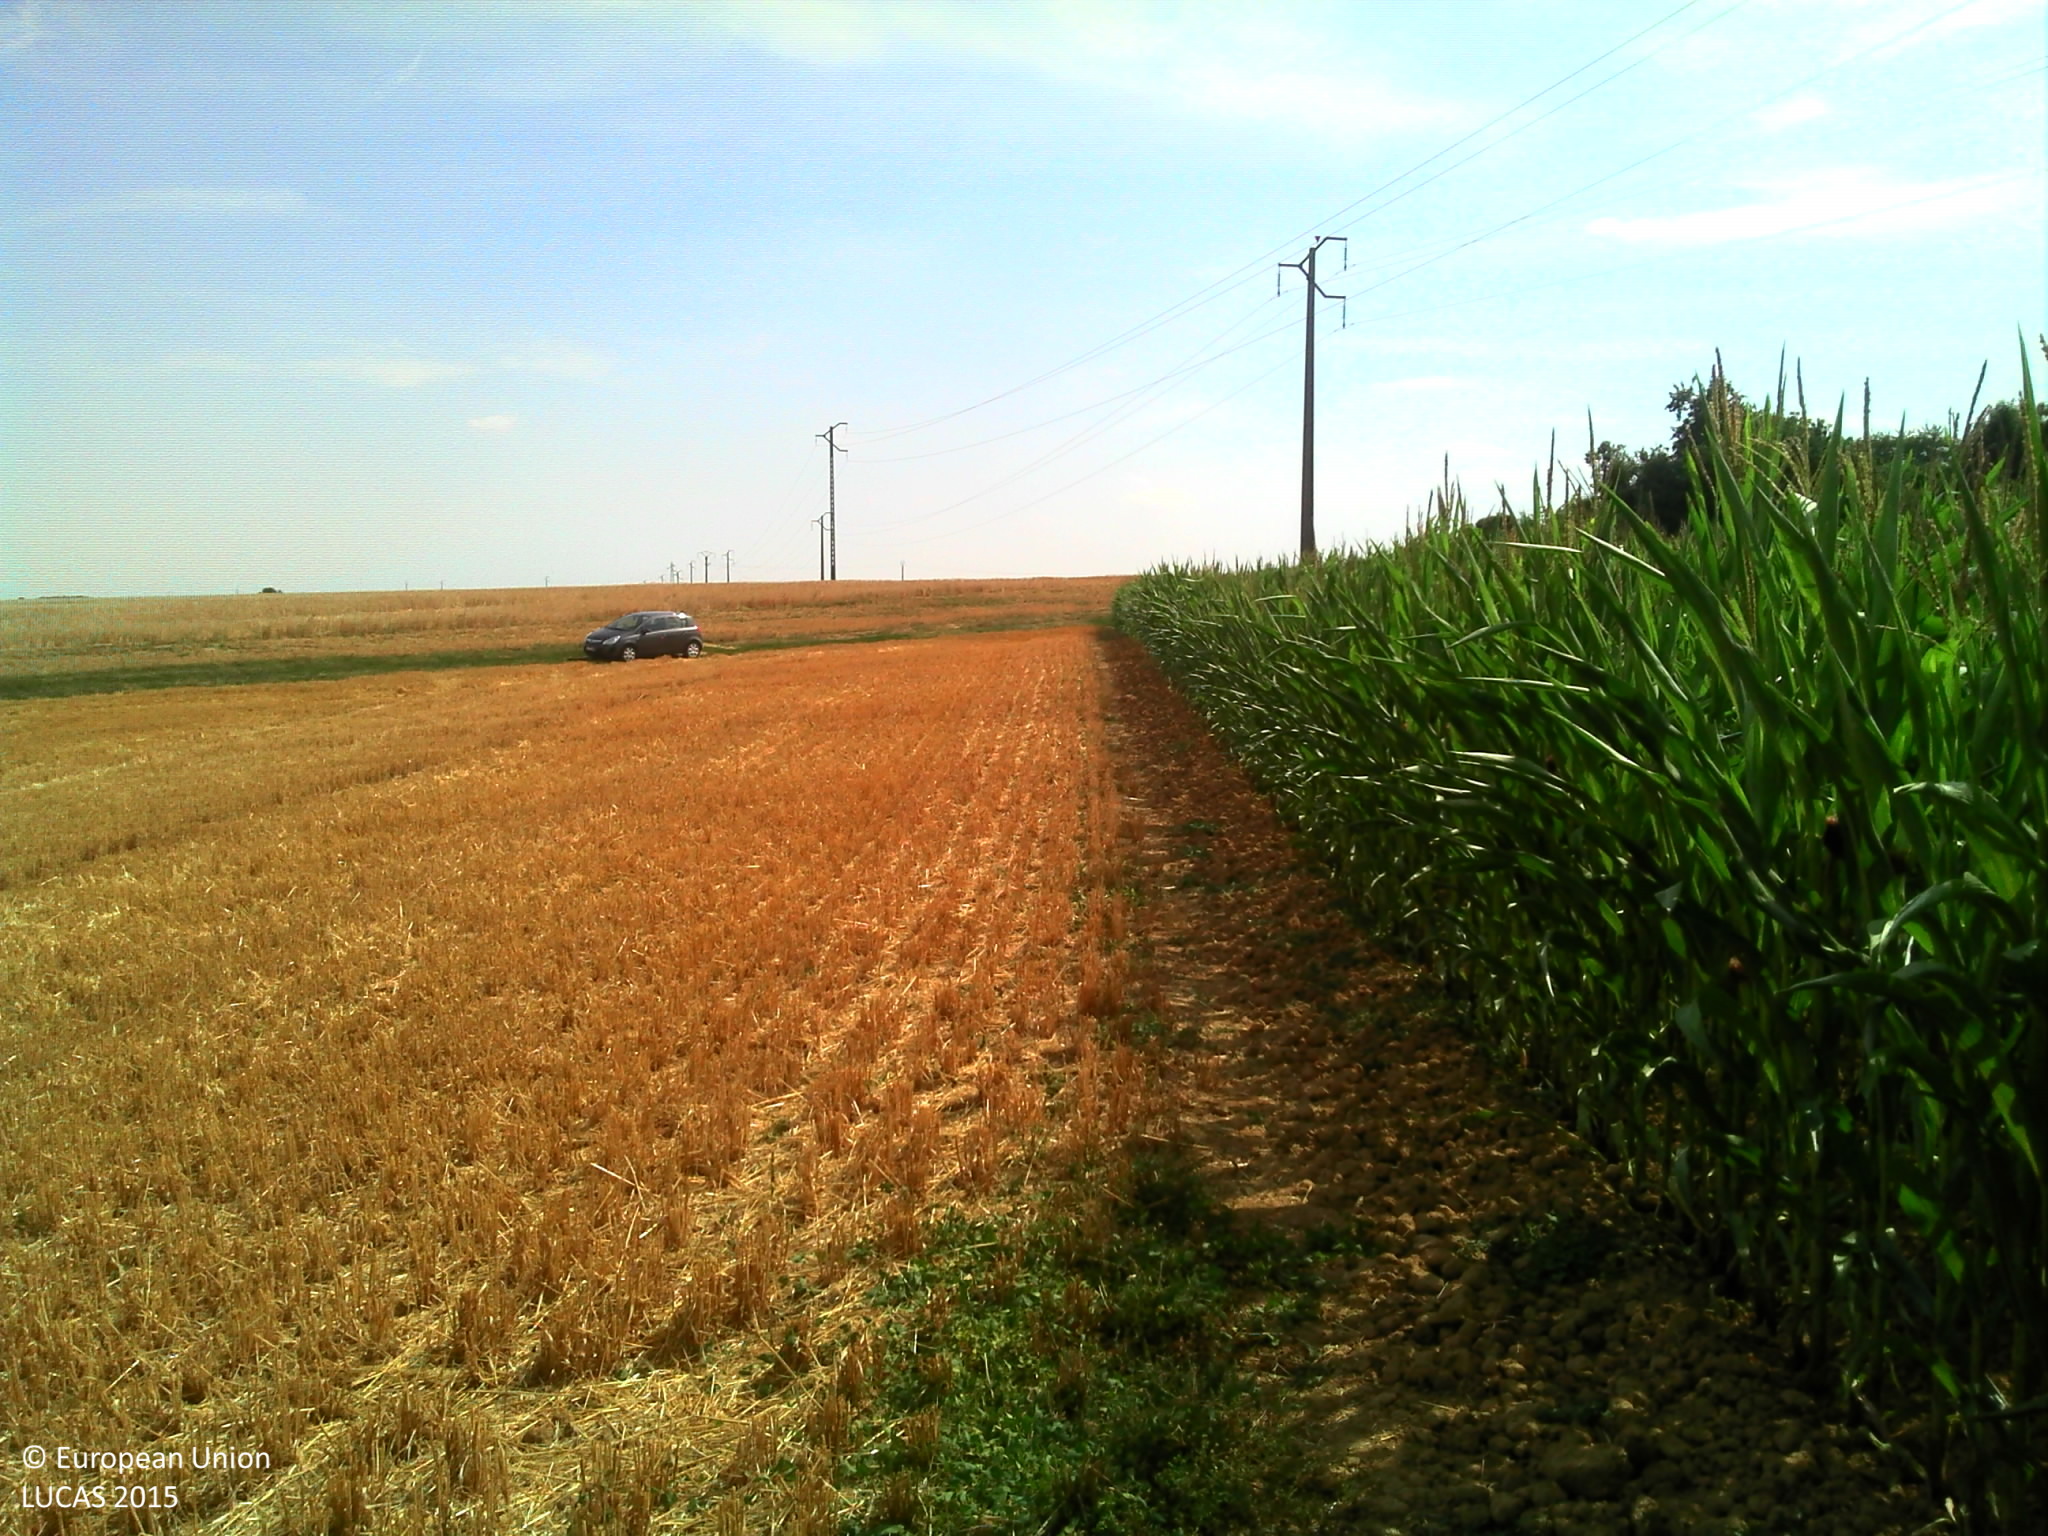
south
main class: Cropland
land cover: Maize
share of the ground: > 75 %
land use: Agriculture (excluding fallow land and kitchen gardens)
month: August
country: FR
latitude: 48.6532
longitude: 3.3279
